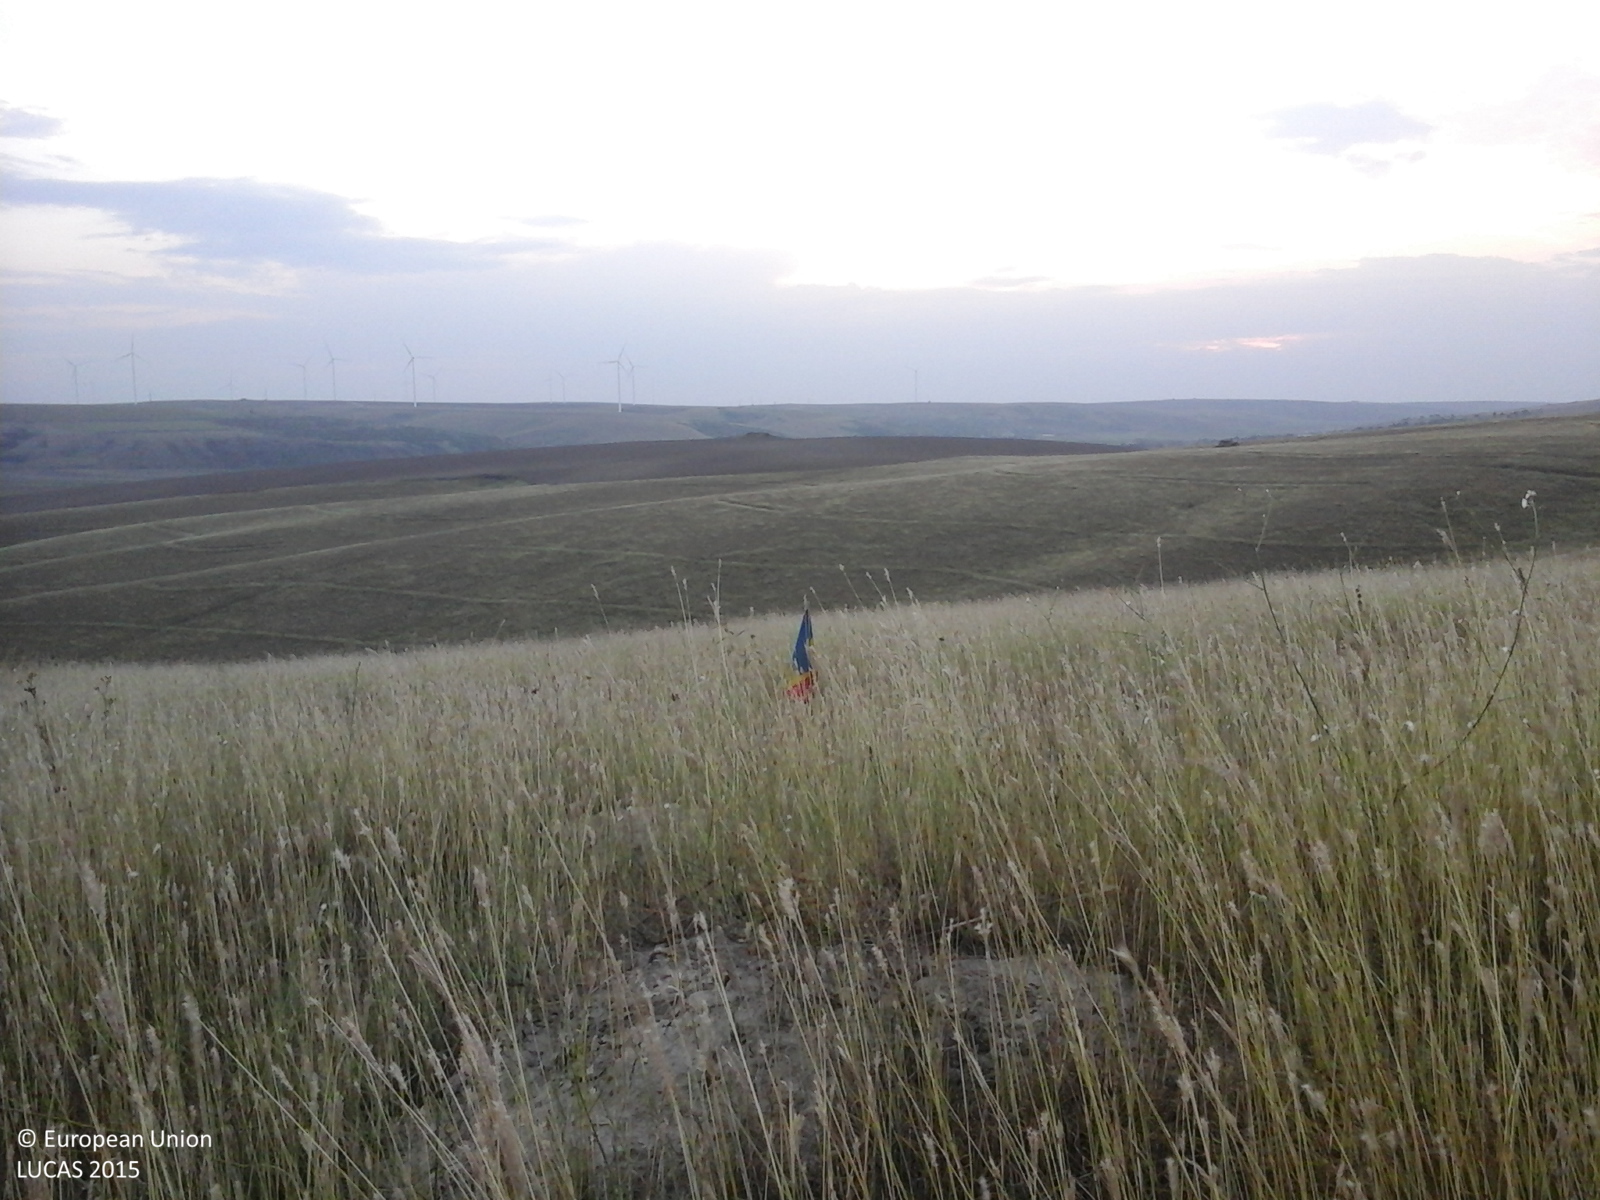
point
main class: Grassland
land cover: Grassland without tree/shrub cover
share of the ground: > 75 %
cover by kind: herbaceous plants 100 %
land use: Agriculture (excluding fallow land and kitchen gardens)
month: August
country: RO
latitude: 44.2194
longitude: 28.0944
